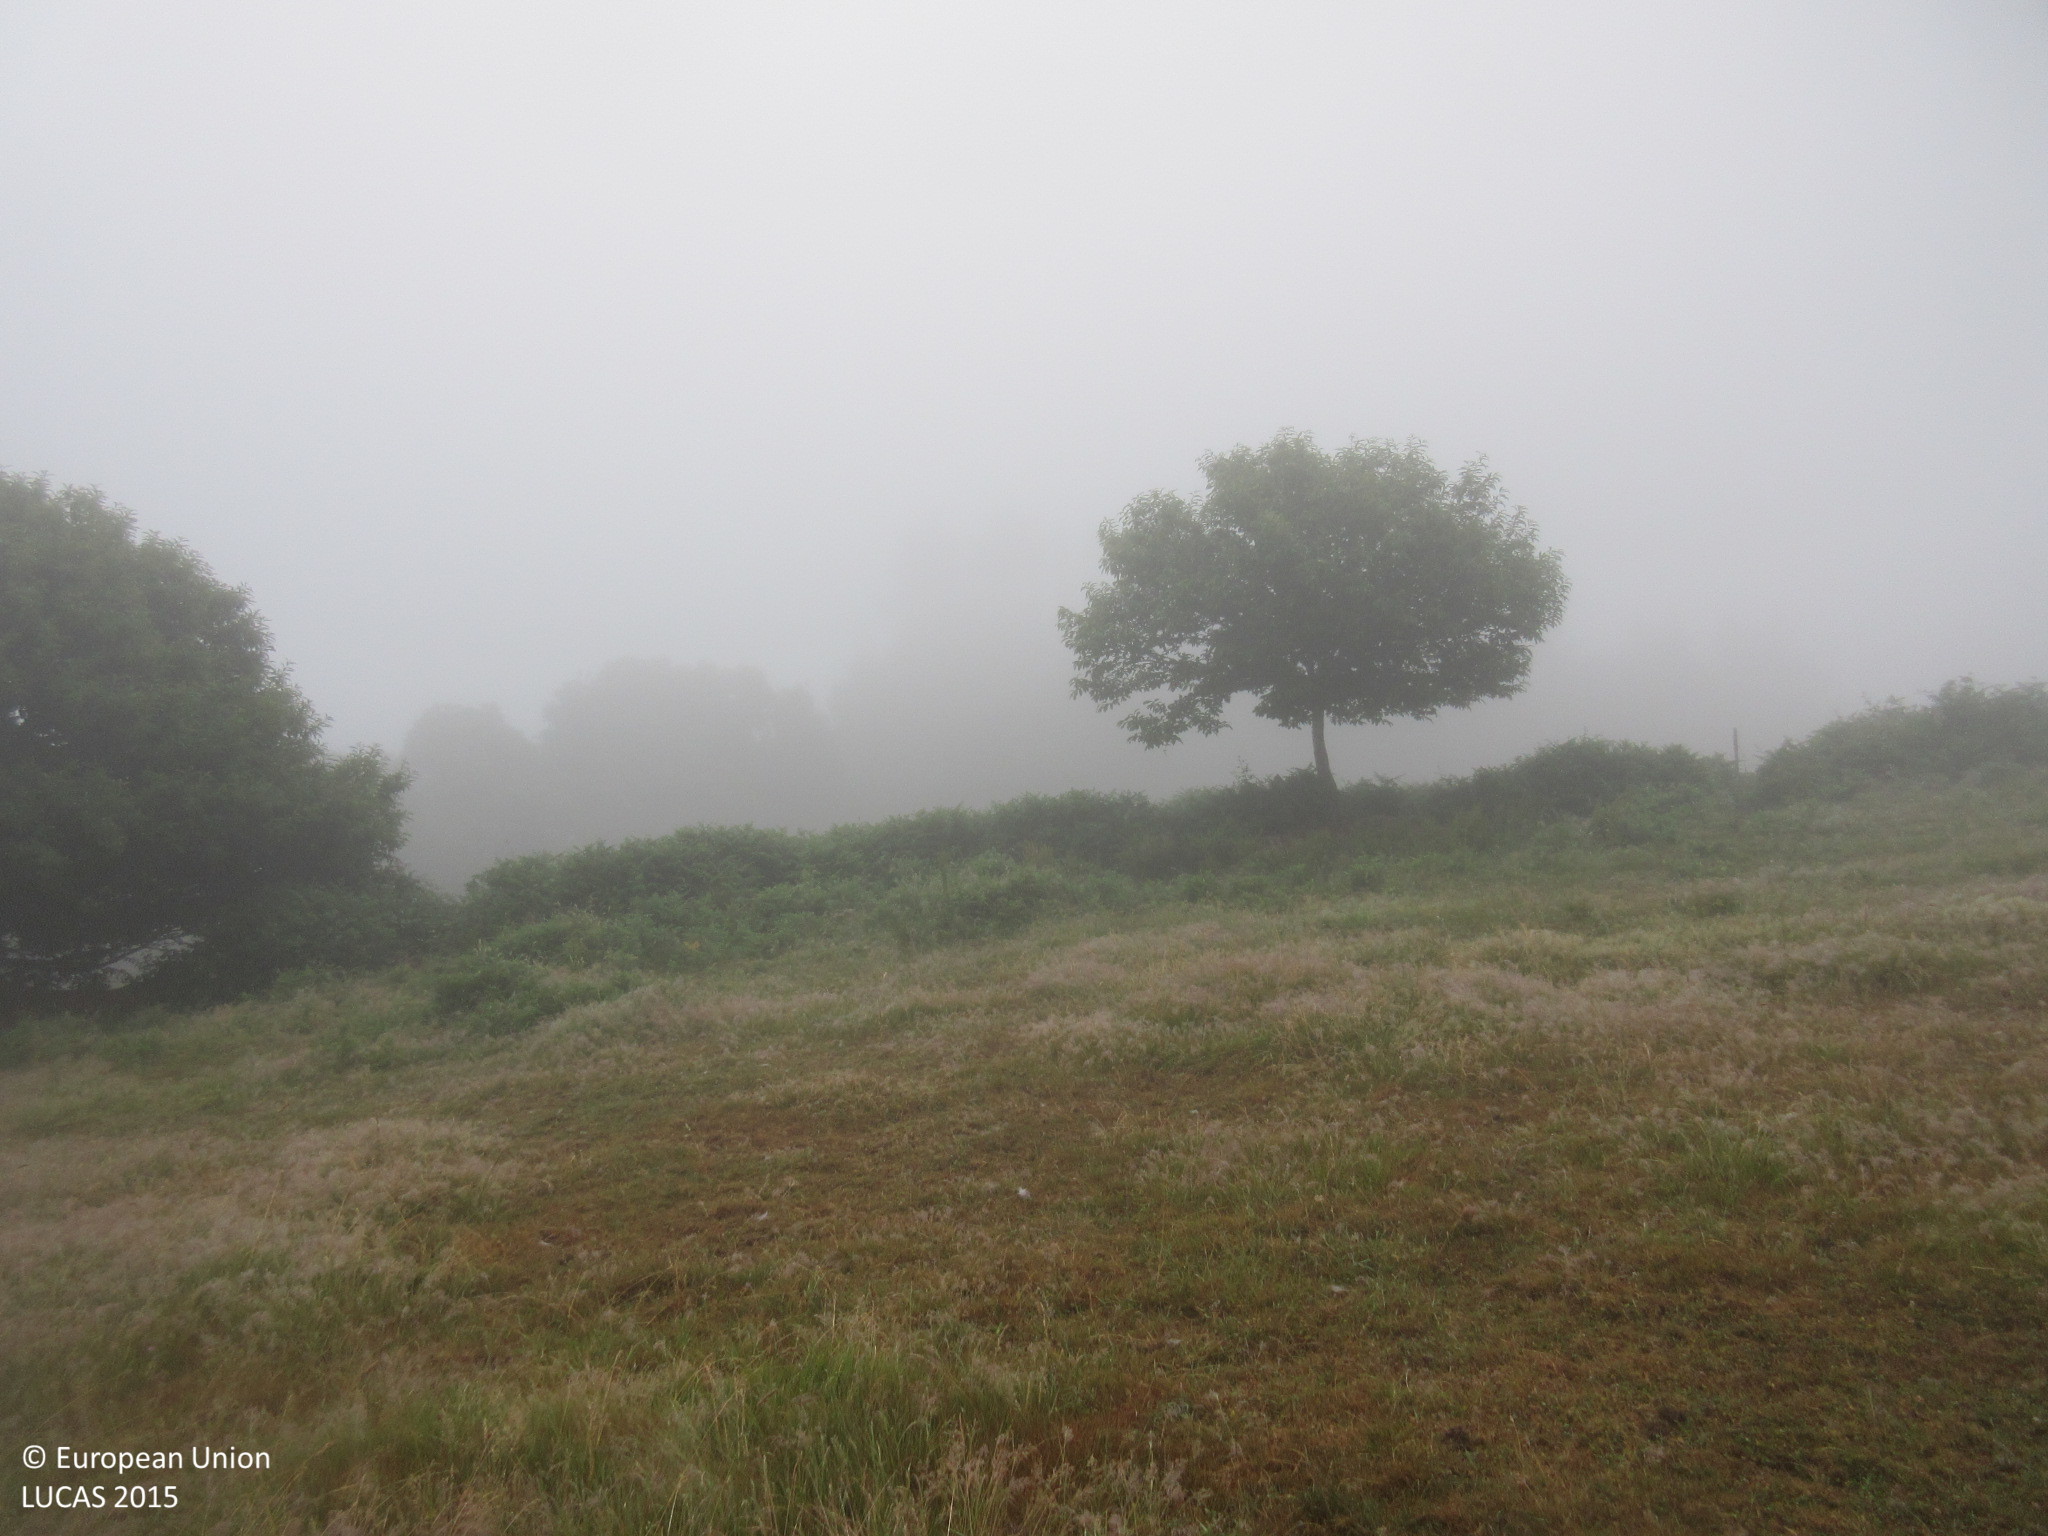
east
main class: Grassland
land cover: Grassland without tree/shrub cover
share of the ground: > 75 %
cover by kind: herbaceous plants 100 %
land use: Agriculture (excluding fallow land and kitchen gardens)
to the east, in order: Grassland without tree/shrub cover; Abandoned hedges; Grassland without tree/shrub cover; Broadleaved woodland; Tracks; Broadleaved woodland
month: June
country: ES
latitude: 43.2399
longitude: -7.0483
